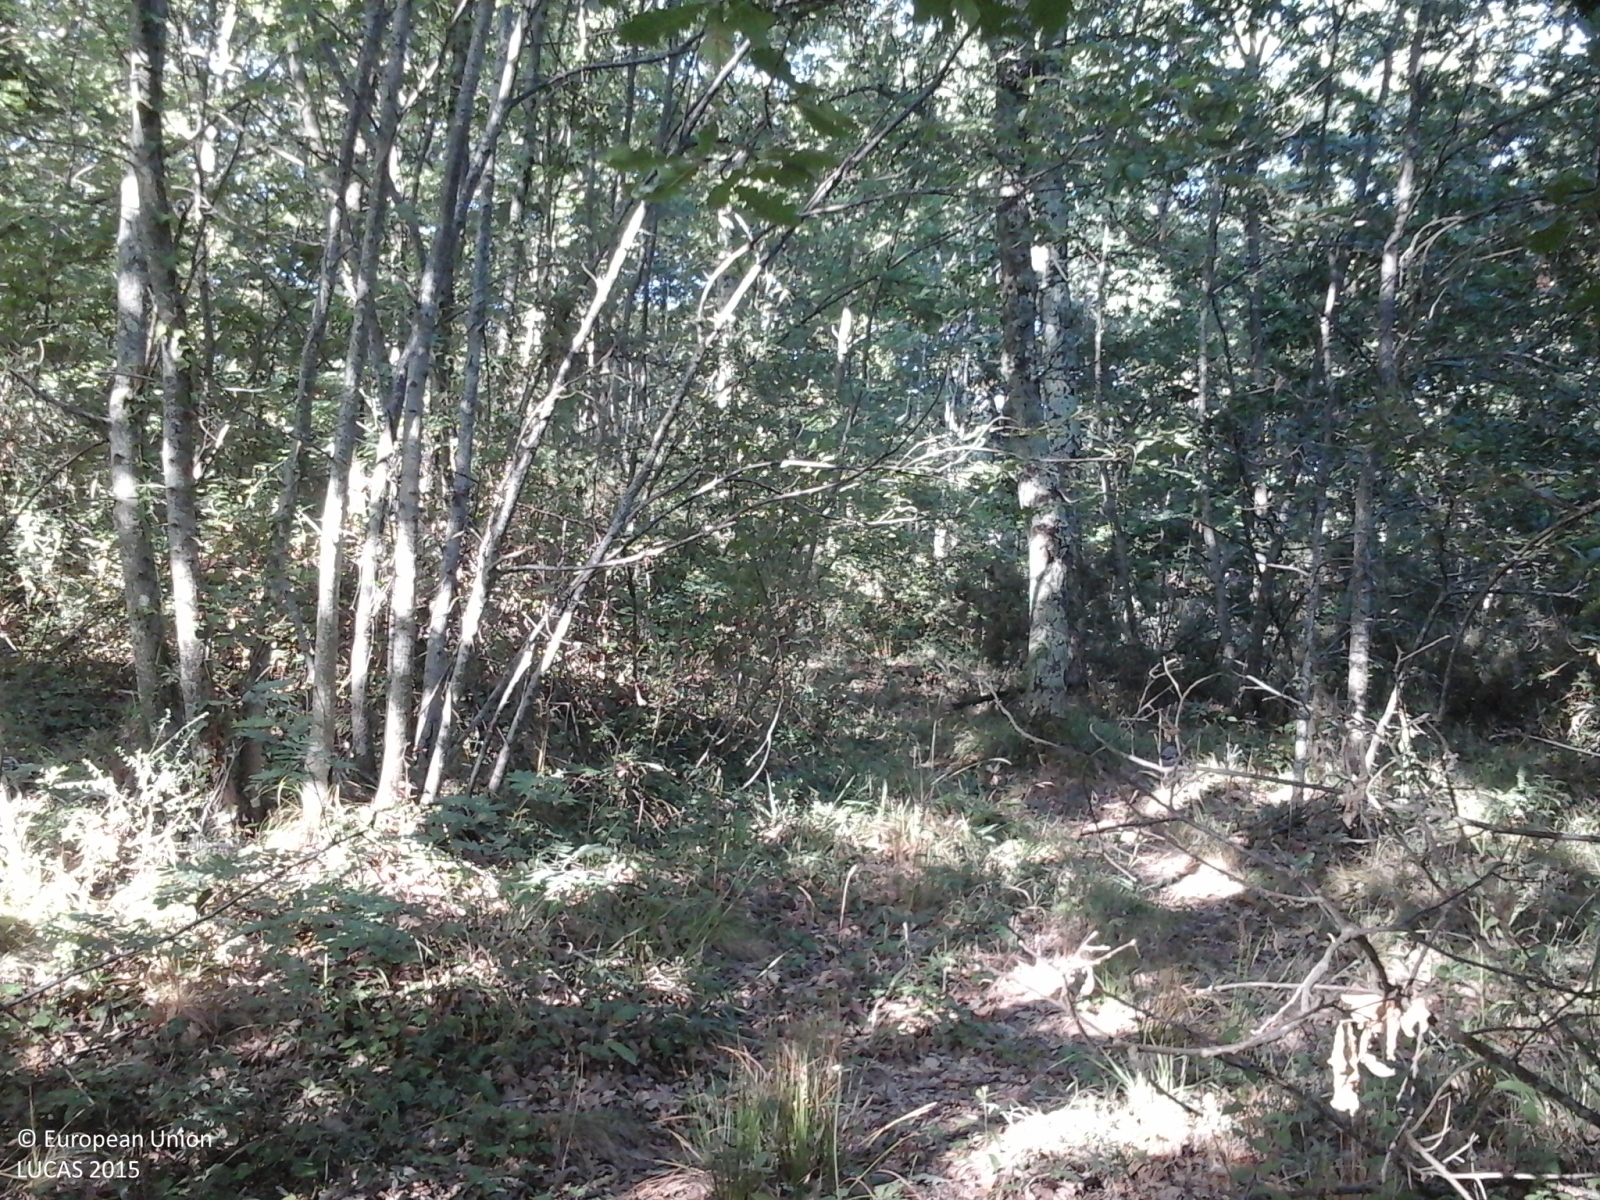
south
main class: Woodland
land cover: Broadleaved woodland
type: thermophilous deciduous forest
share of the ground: > 75 %
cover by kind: broadleaved forest trees 100 %
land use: Forestry
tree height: > 5 m
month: July
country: IT
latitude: 43.5167
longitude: 10.9006
